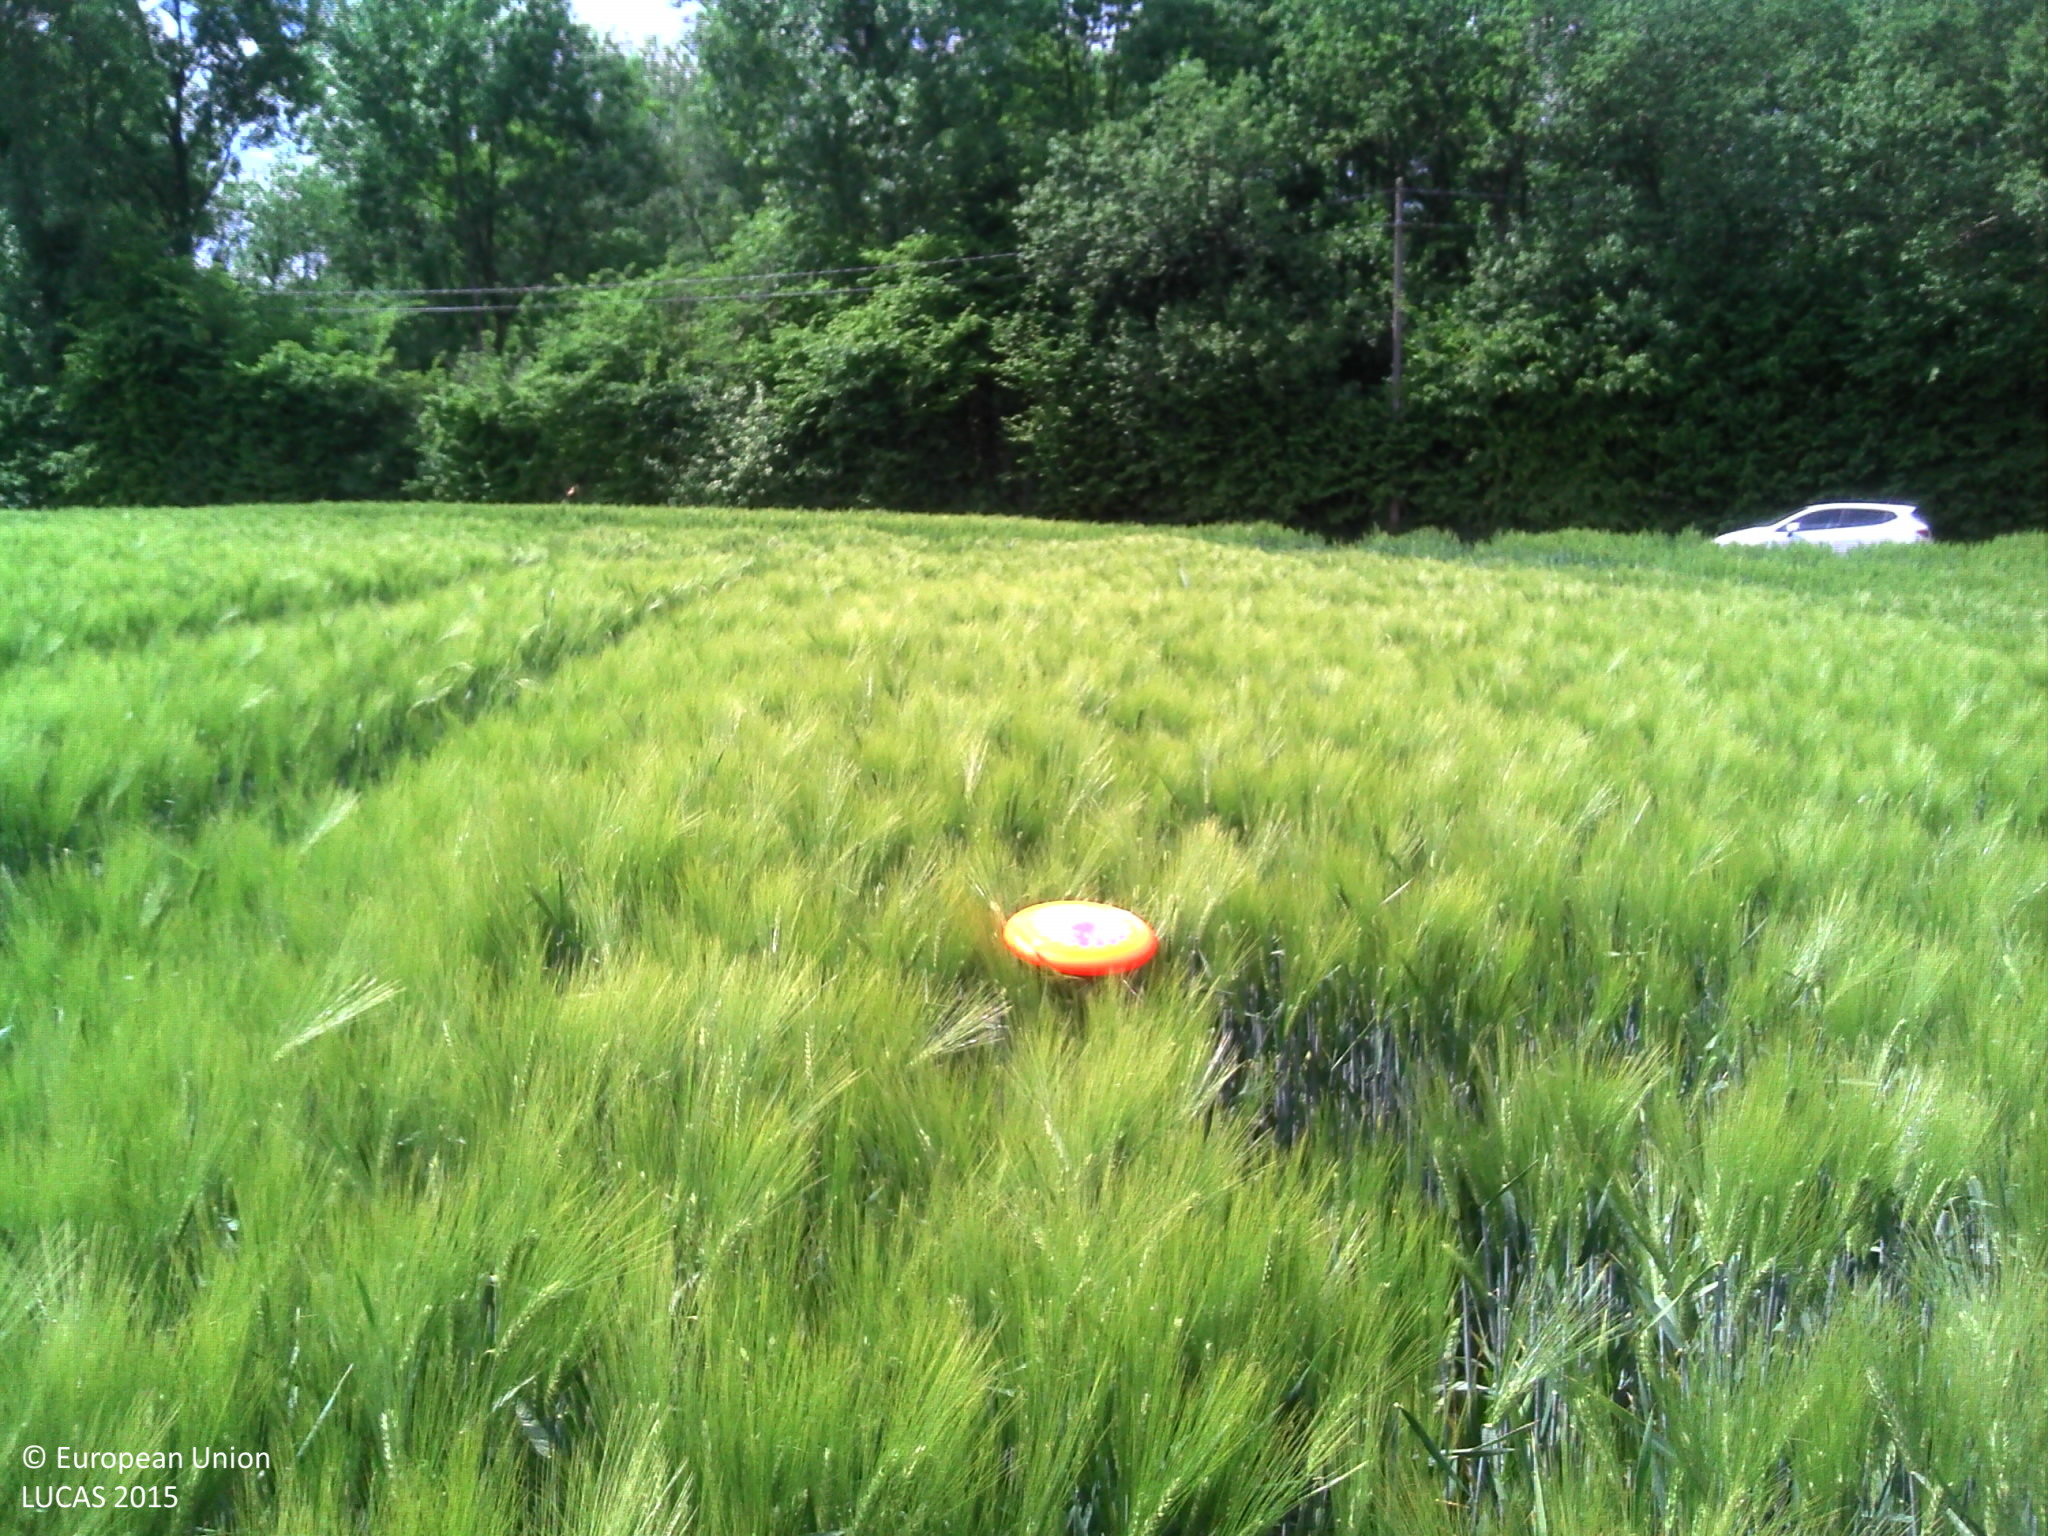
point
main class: Cropland
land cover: Barley
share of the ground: > 75 %
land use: Agriculture (excluding fallow land and kitchen gardens)
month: May
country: BE
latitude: 50.5909
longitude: 4.4726
